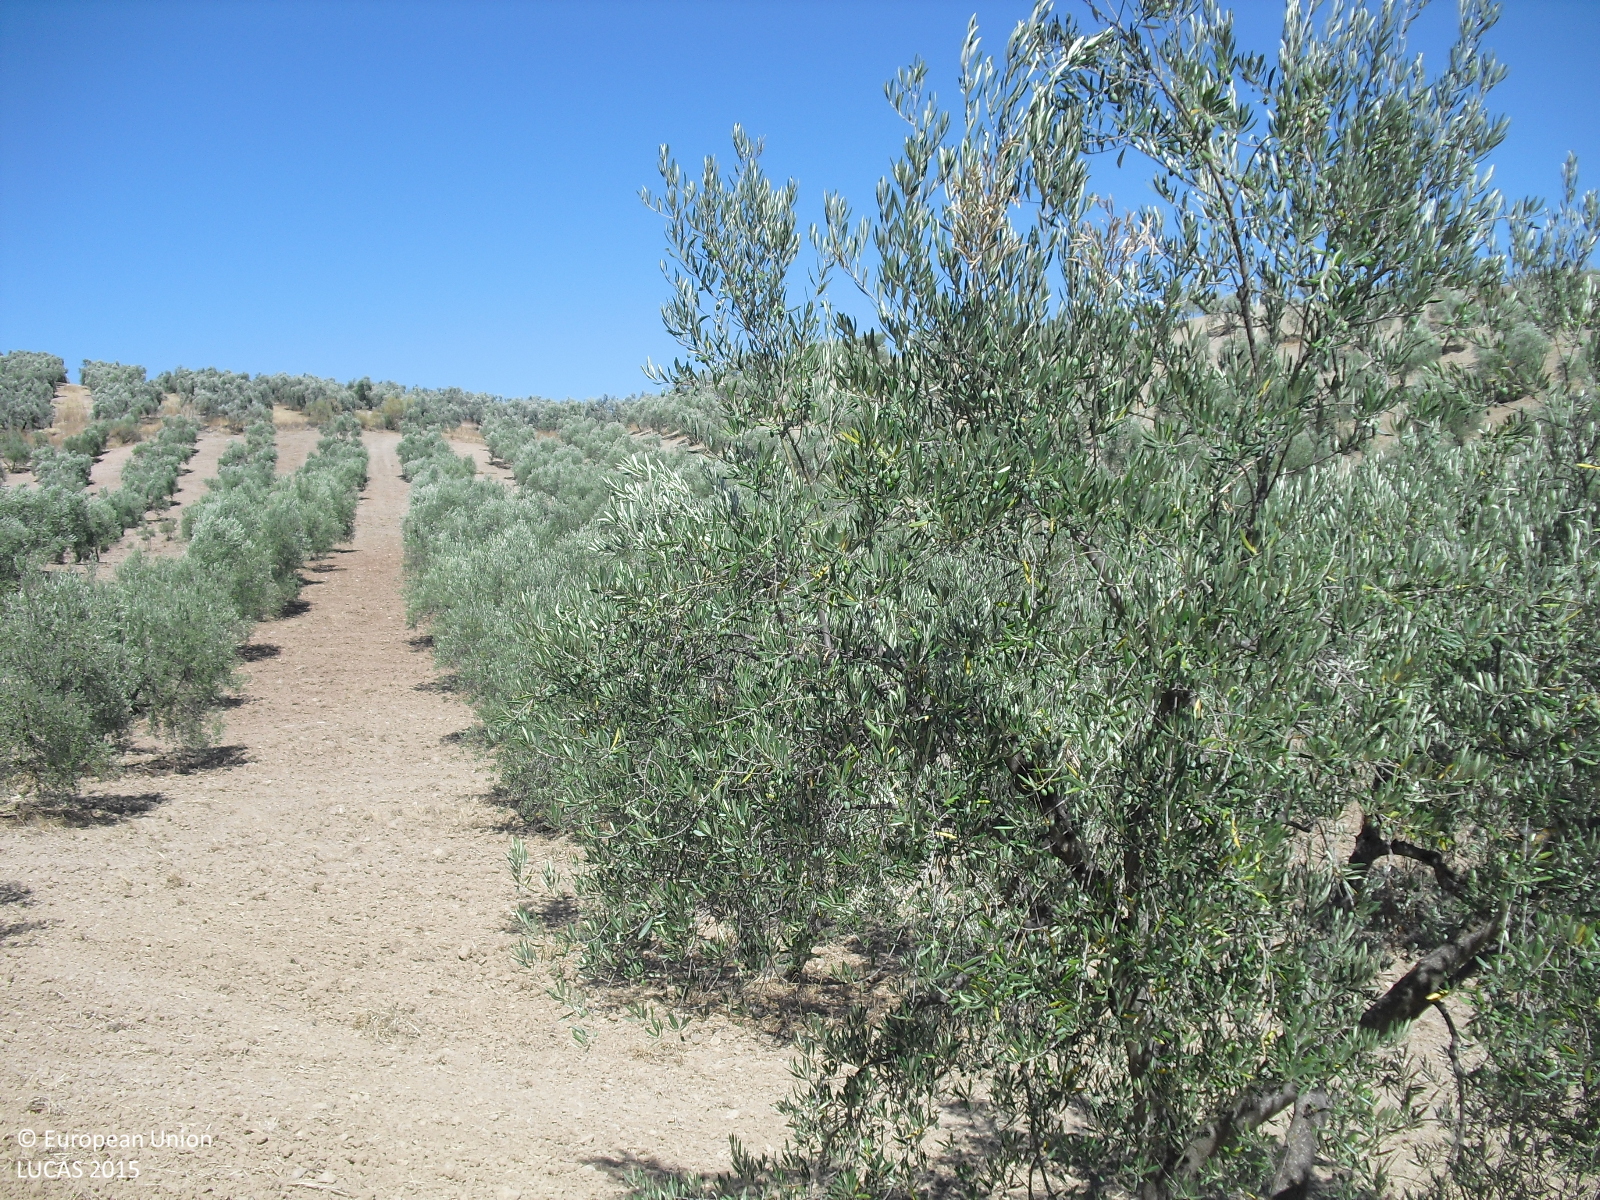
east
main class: Cropland
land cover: Olive groves
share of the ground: 25 - 50 %
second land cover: Other bare soil
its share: > 75 %
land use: Agriculture (excluding fallow land and kitchen gardens)
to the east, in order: Olive groves; Other bare soil; Grass margins
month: July
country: ES
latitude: 37.0091
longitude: -5.4610
